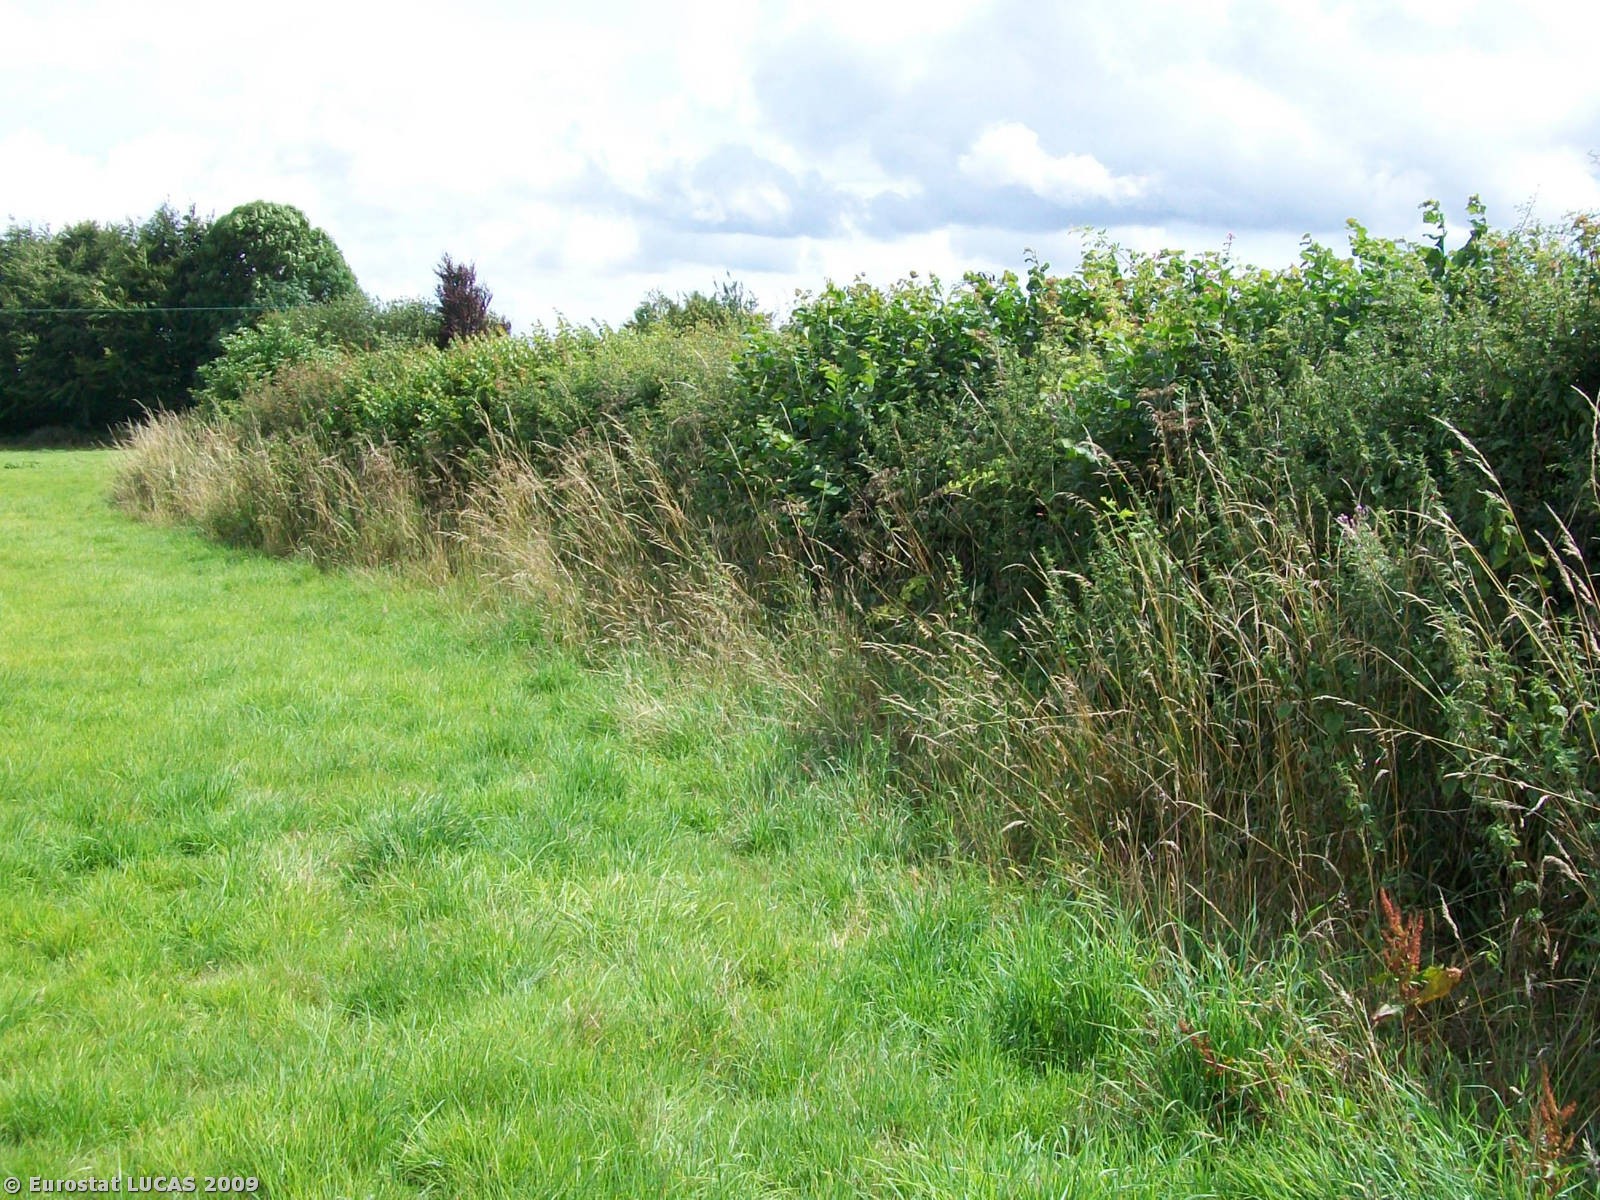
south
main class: Grassland
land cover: Grassland without tree/shrub cover
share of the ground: > 75 %
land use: Agriculture (excluding fallow land and kitchen gardens)
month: July
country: GB
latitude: 51.5020
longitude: -2.2646
